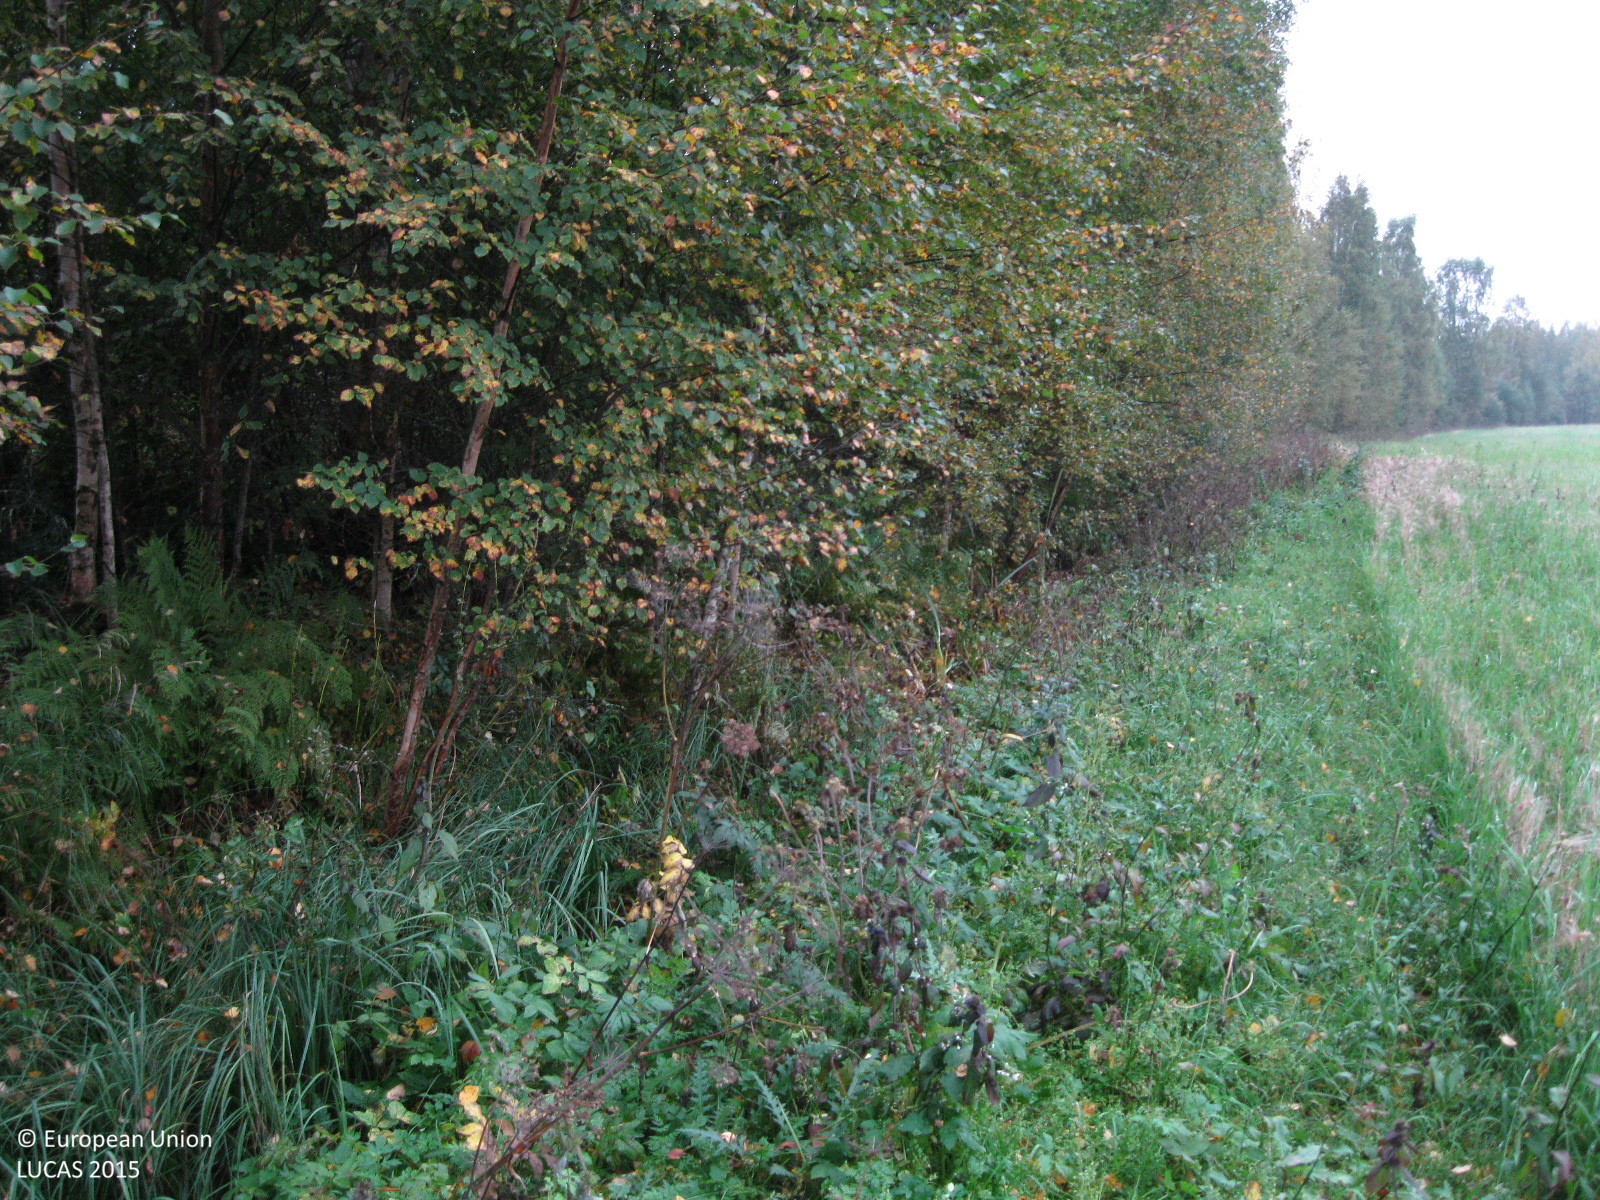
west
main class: Cropland
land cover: Barley
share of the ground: 50 - 75 %
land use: Agriculture (excluding fallow land and kitchen gardens)
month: September
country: FI
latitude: 60.8660
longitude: 24.5970
